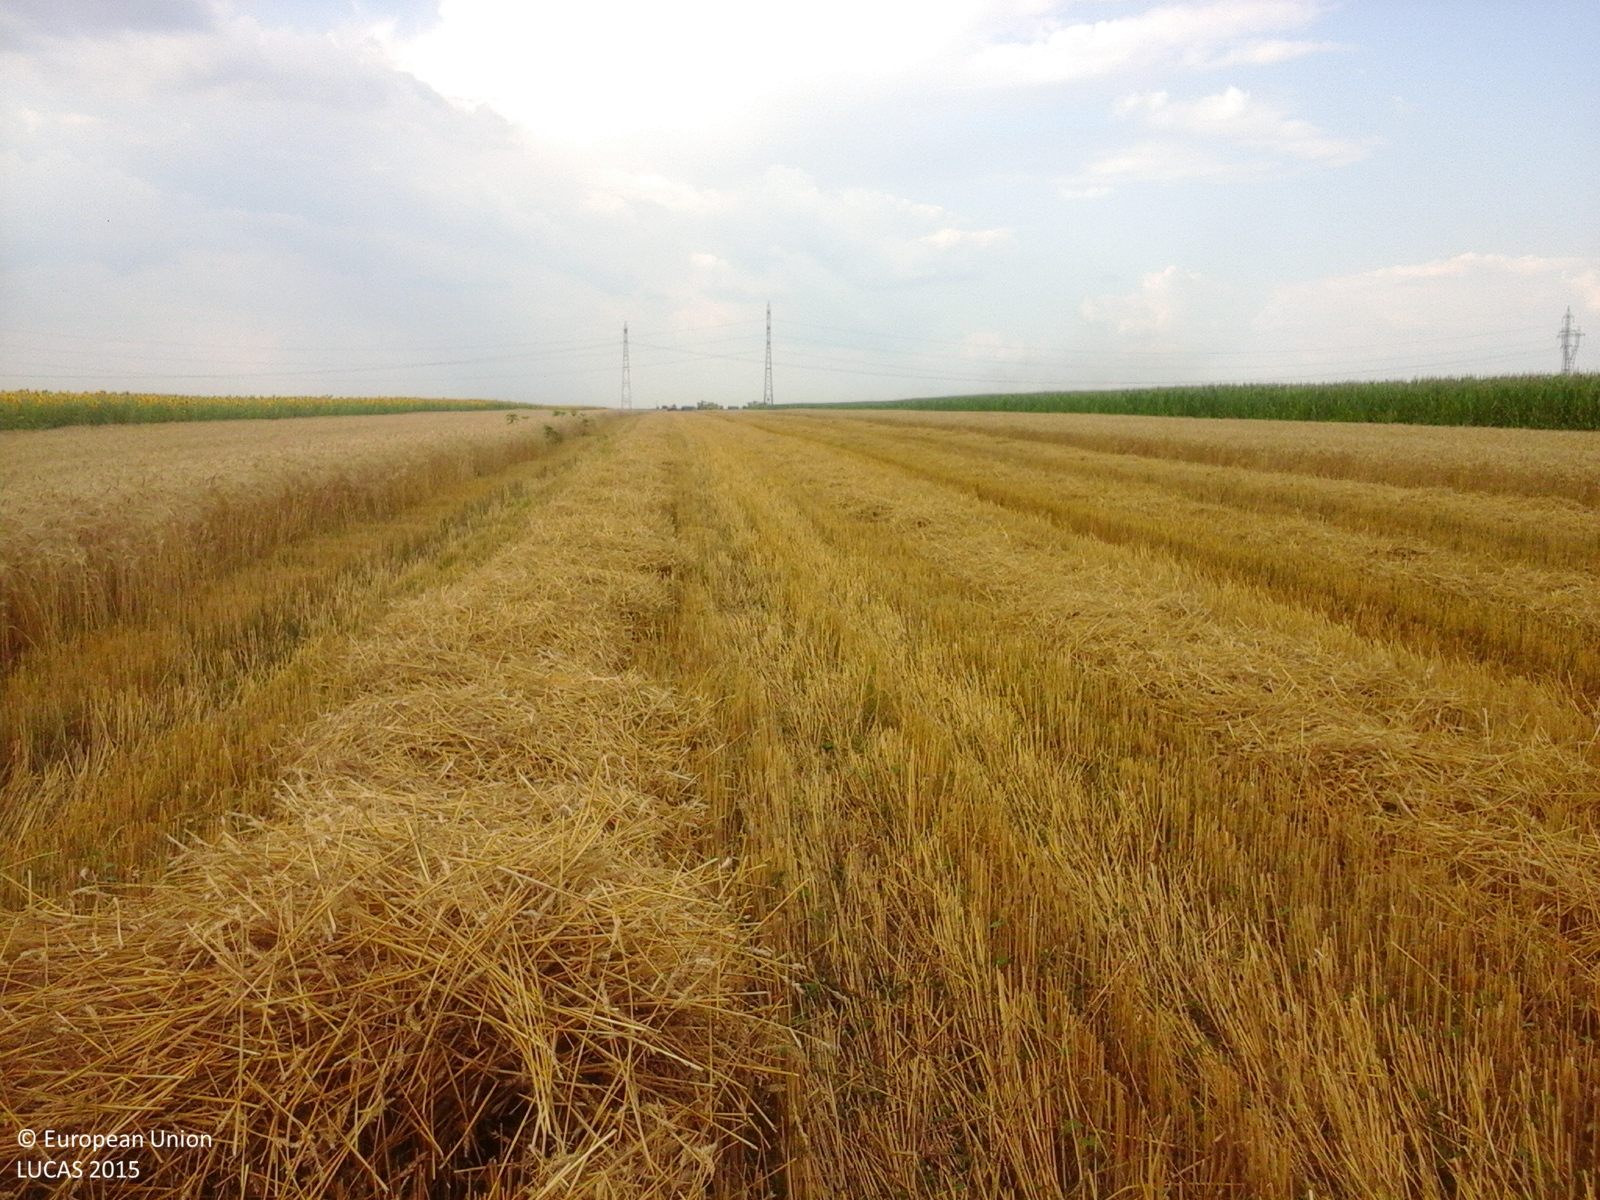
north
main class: Cropland
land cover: Common wheat
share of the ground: > 75 %
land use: Agriculture (excluding fallow land and kitchen gardens)
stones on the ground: < 10 %
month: July
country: RO
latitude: 43.9317
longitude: 25.7241
